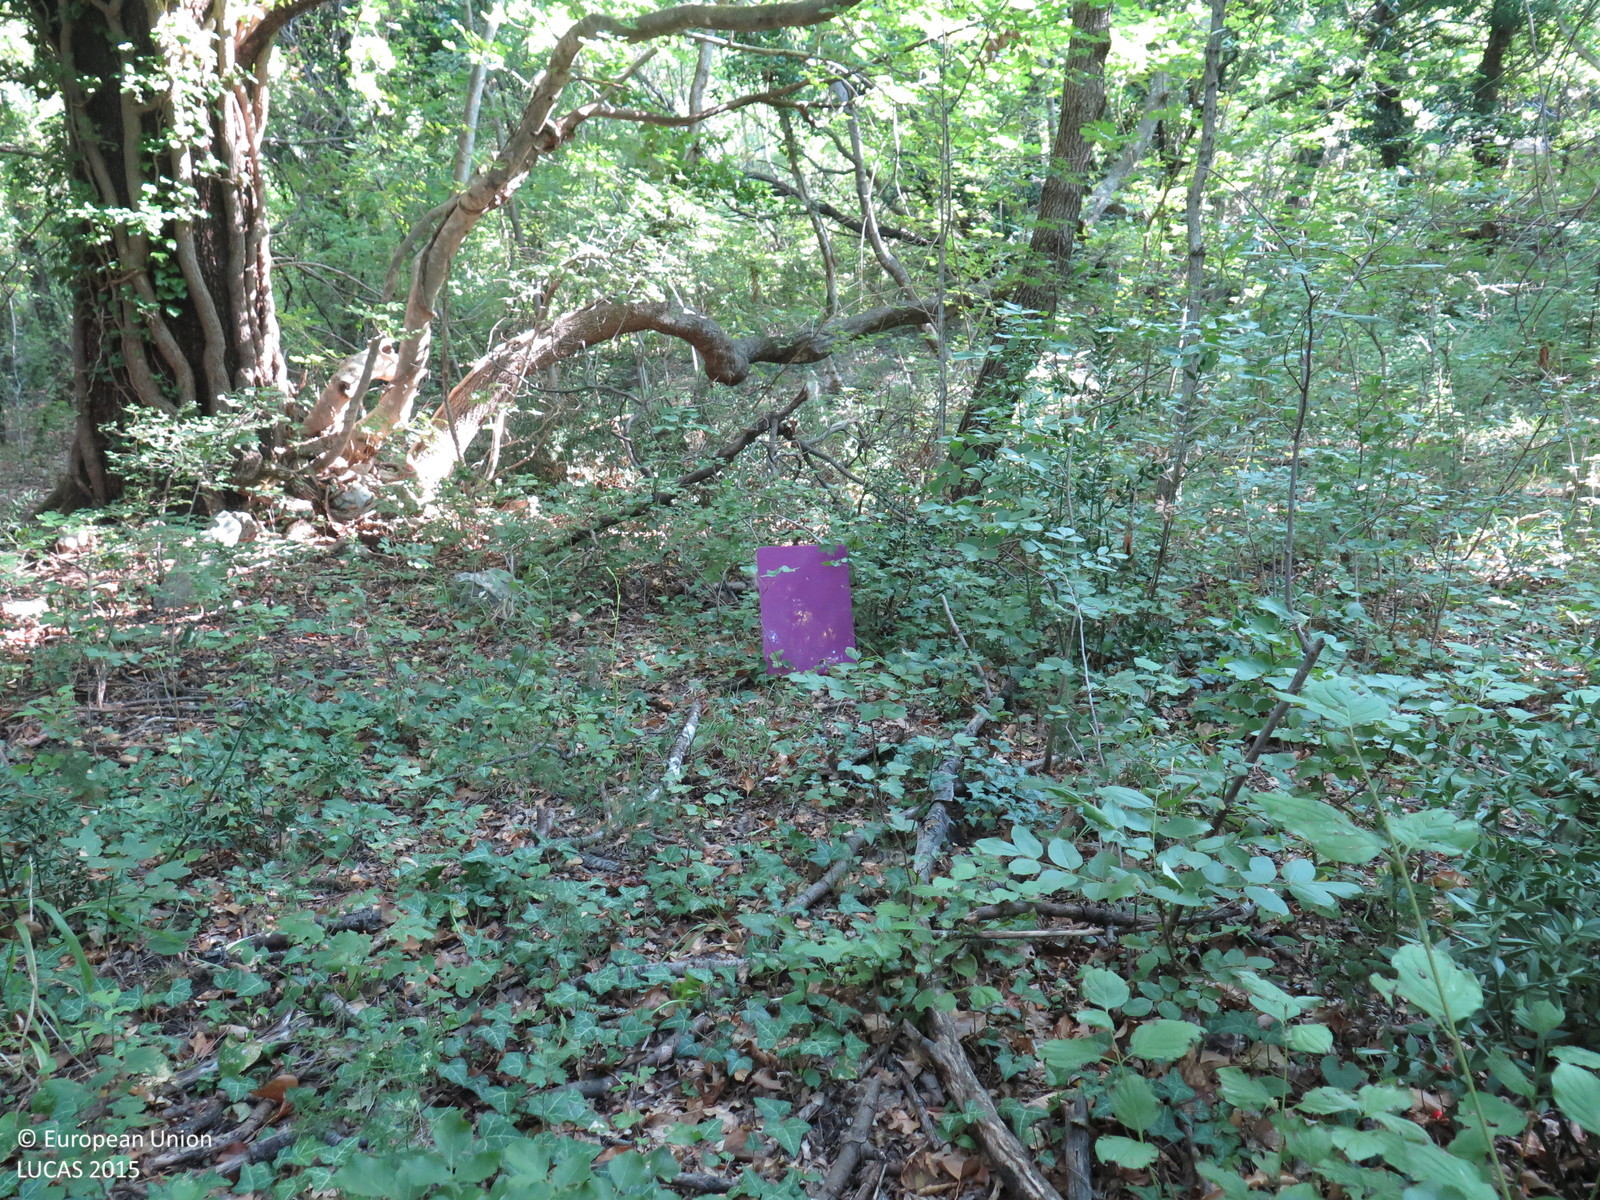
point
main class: Woodland
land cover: Broadleaved woodland
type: mesophytic deciduous forest
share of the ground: > 75 %
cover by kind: broadleaved forest trees 90 %, shrubs 5 %, herbaceous plants 5 %
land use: Semi-natural and natural areas not in use
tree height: > 5 m
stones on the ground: 25 - 50 %
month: August
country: HR
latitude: 45.2004
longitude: 14.7177
